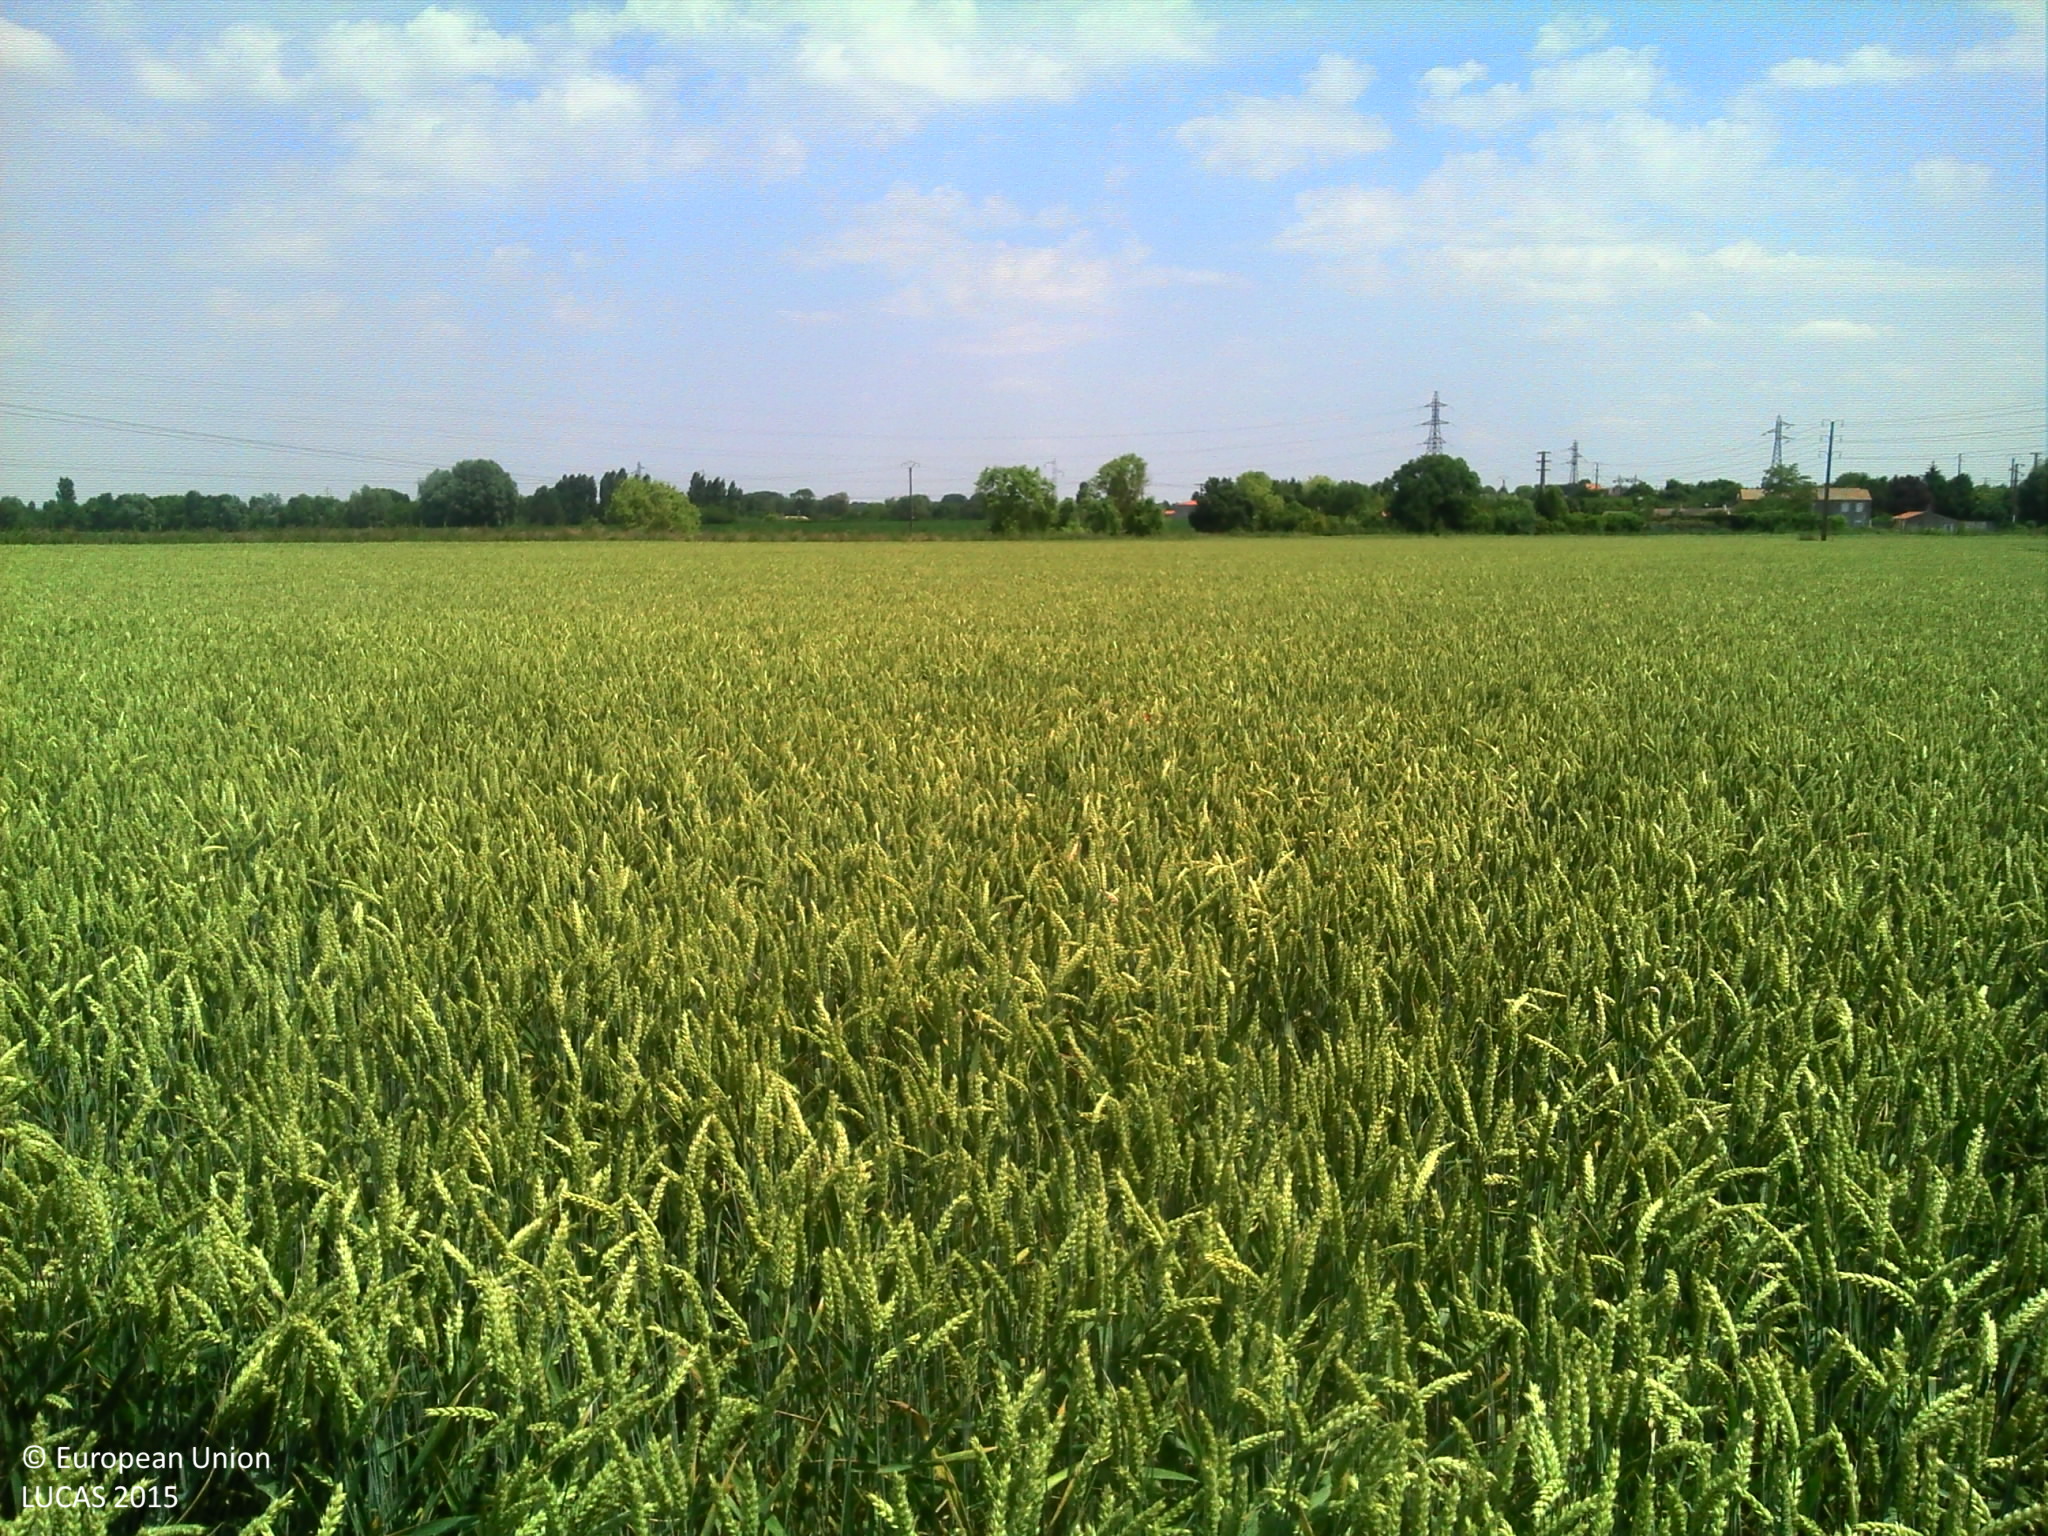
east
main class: Cropland
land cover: Common wheat
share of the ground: > 75 %
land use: Agriculture (excluding fallow land and kitchen gardens)
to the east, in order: Common wheat; Spontaneously vegetated surfaces; Inland fresh running water; Grass margins; Maize; Electric lines; Maize
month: June
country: FR
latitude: 45.9529
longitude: -0.9301
